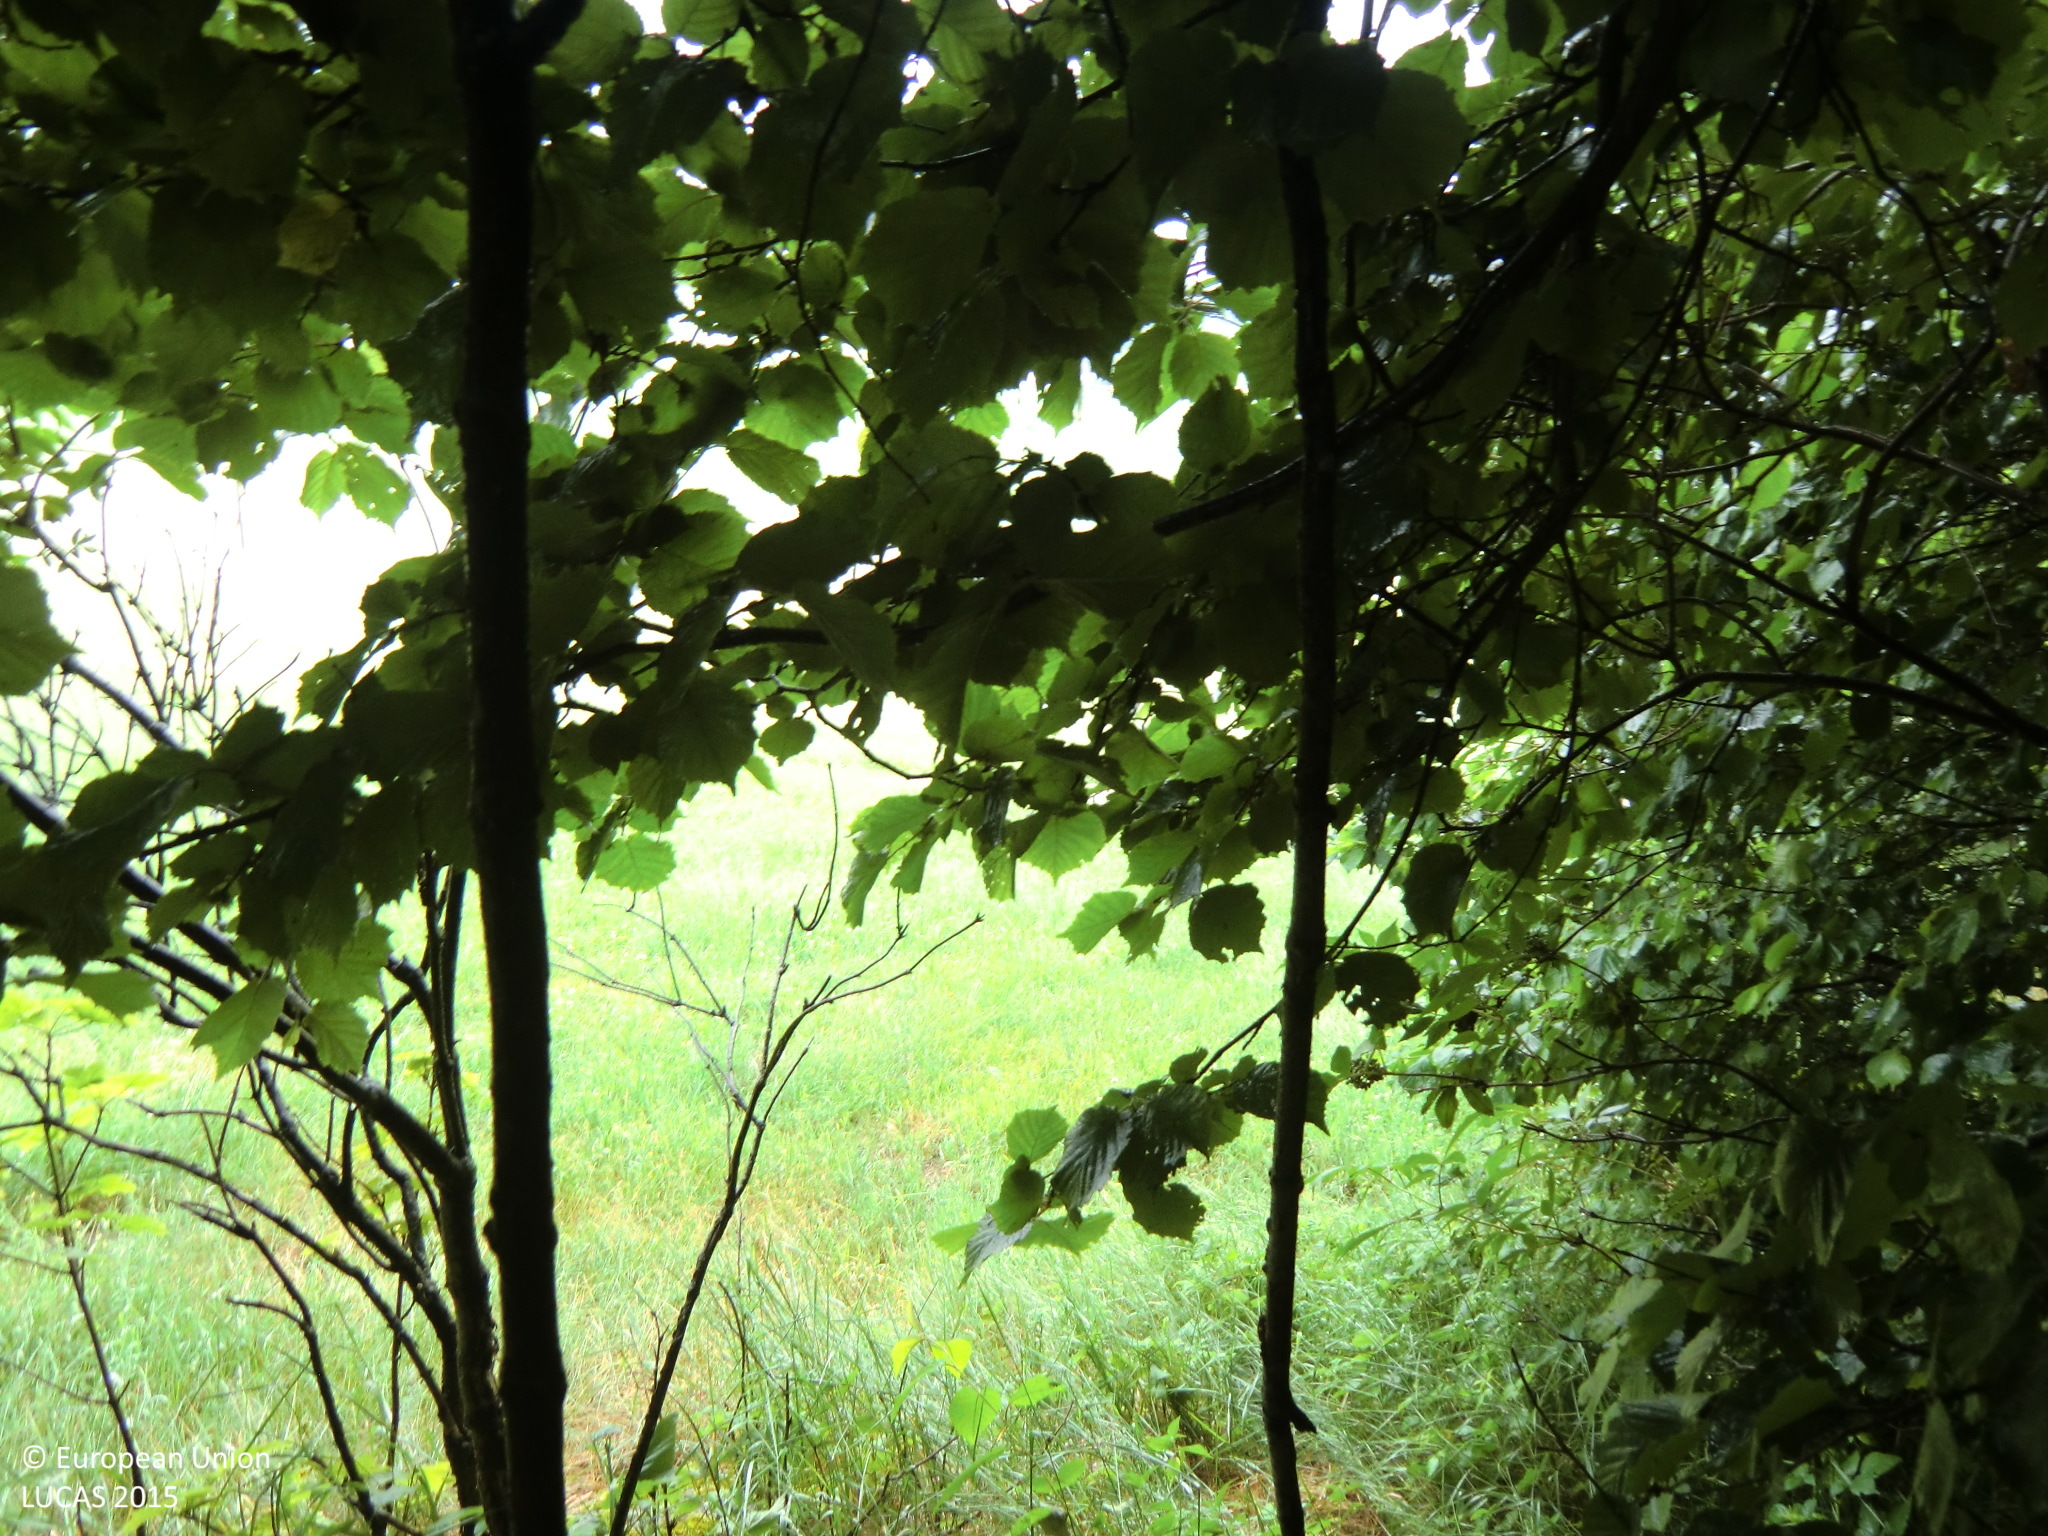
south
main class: Woodland
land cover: Spruce dominated mixed woodland
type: hemiboreal forest and nemoral coniferous forest and mixed broadleaved-coniferous forest
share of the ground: > 75 %
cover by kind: coniferous forest trees 45 %, broadleaved forest trees 40 %, shrubs 5 %, lichens and mosses 5 %, consolidated bare surface 5 %
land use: Forestry
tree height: > 5 m
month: June
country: AT
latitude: 48.4874
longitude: 14.6147
